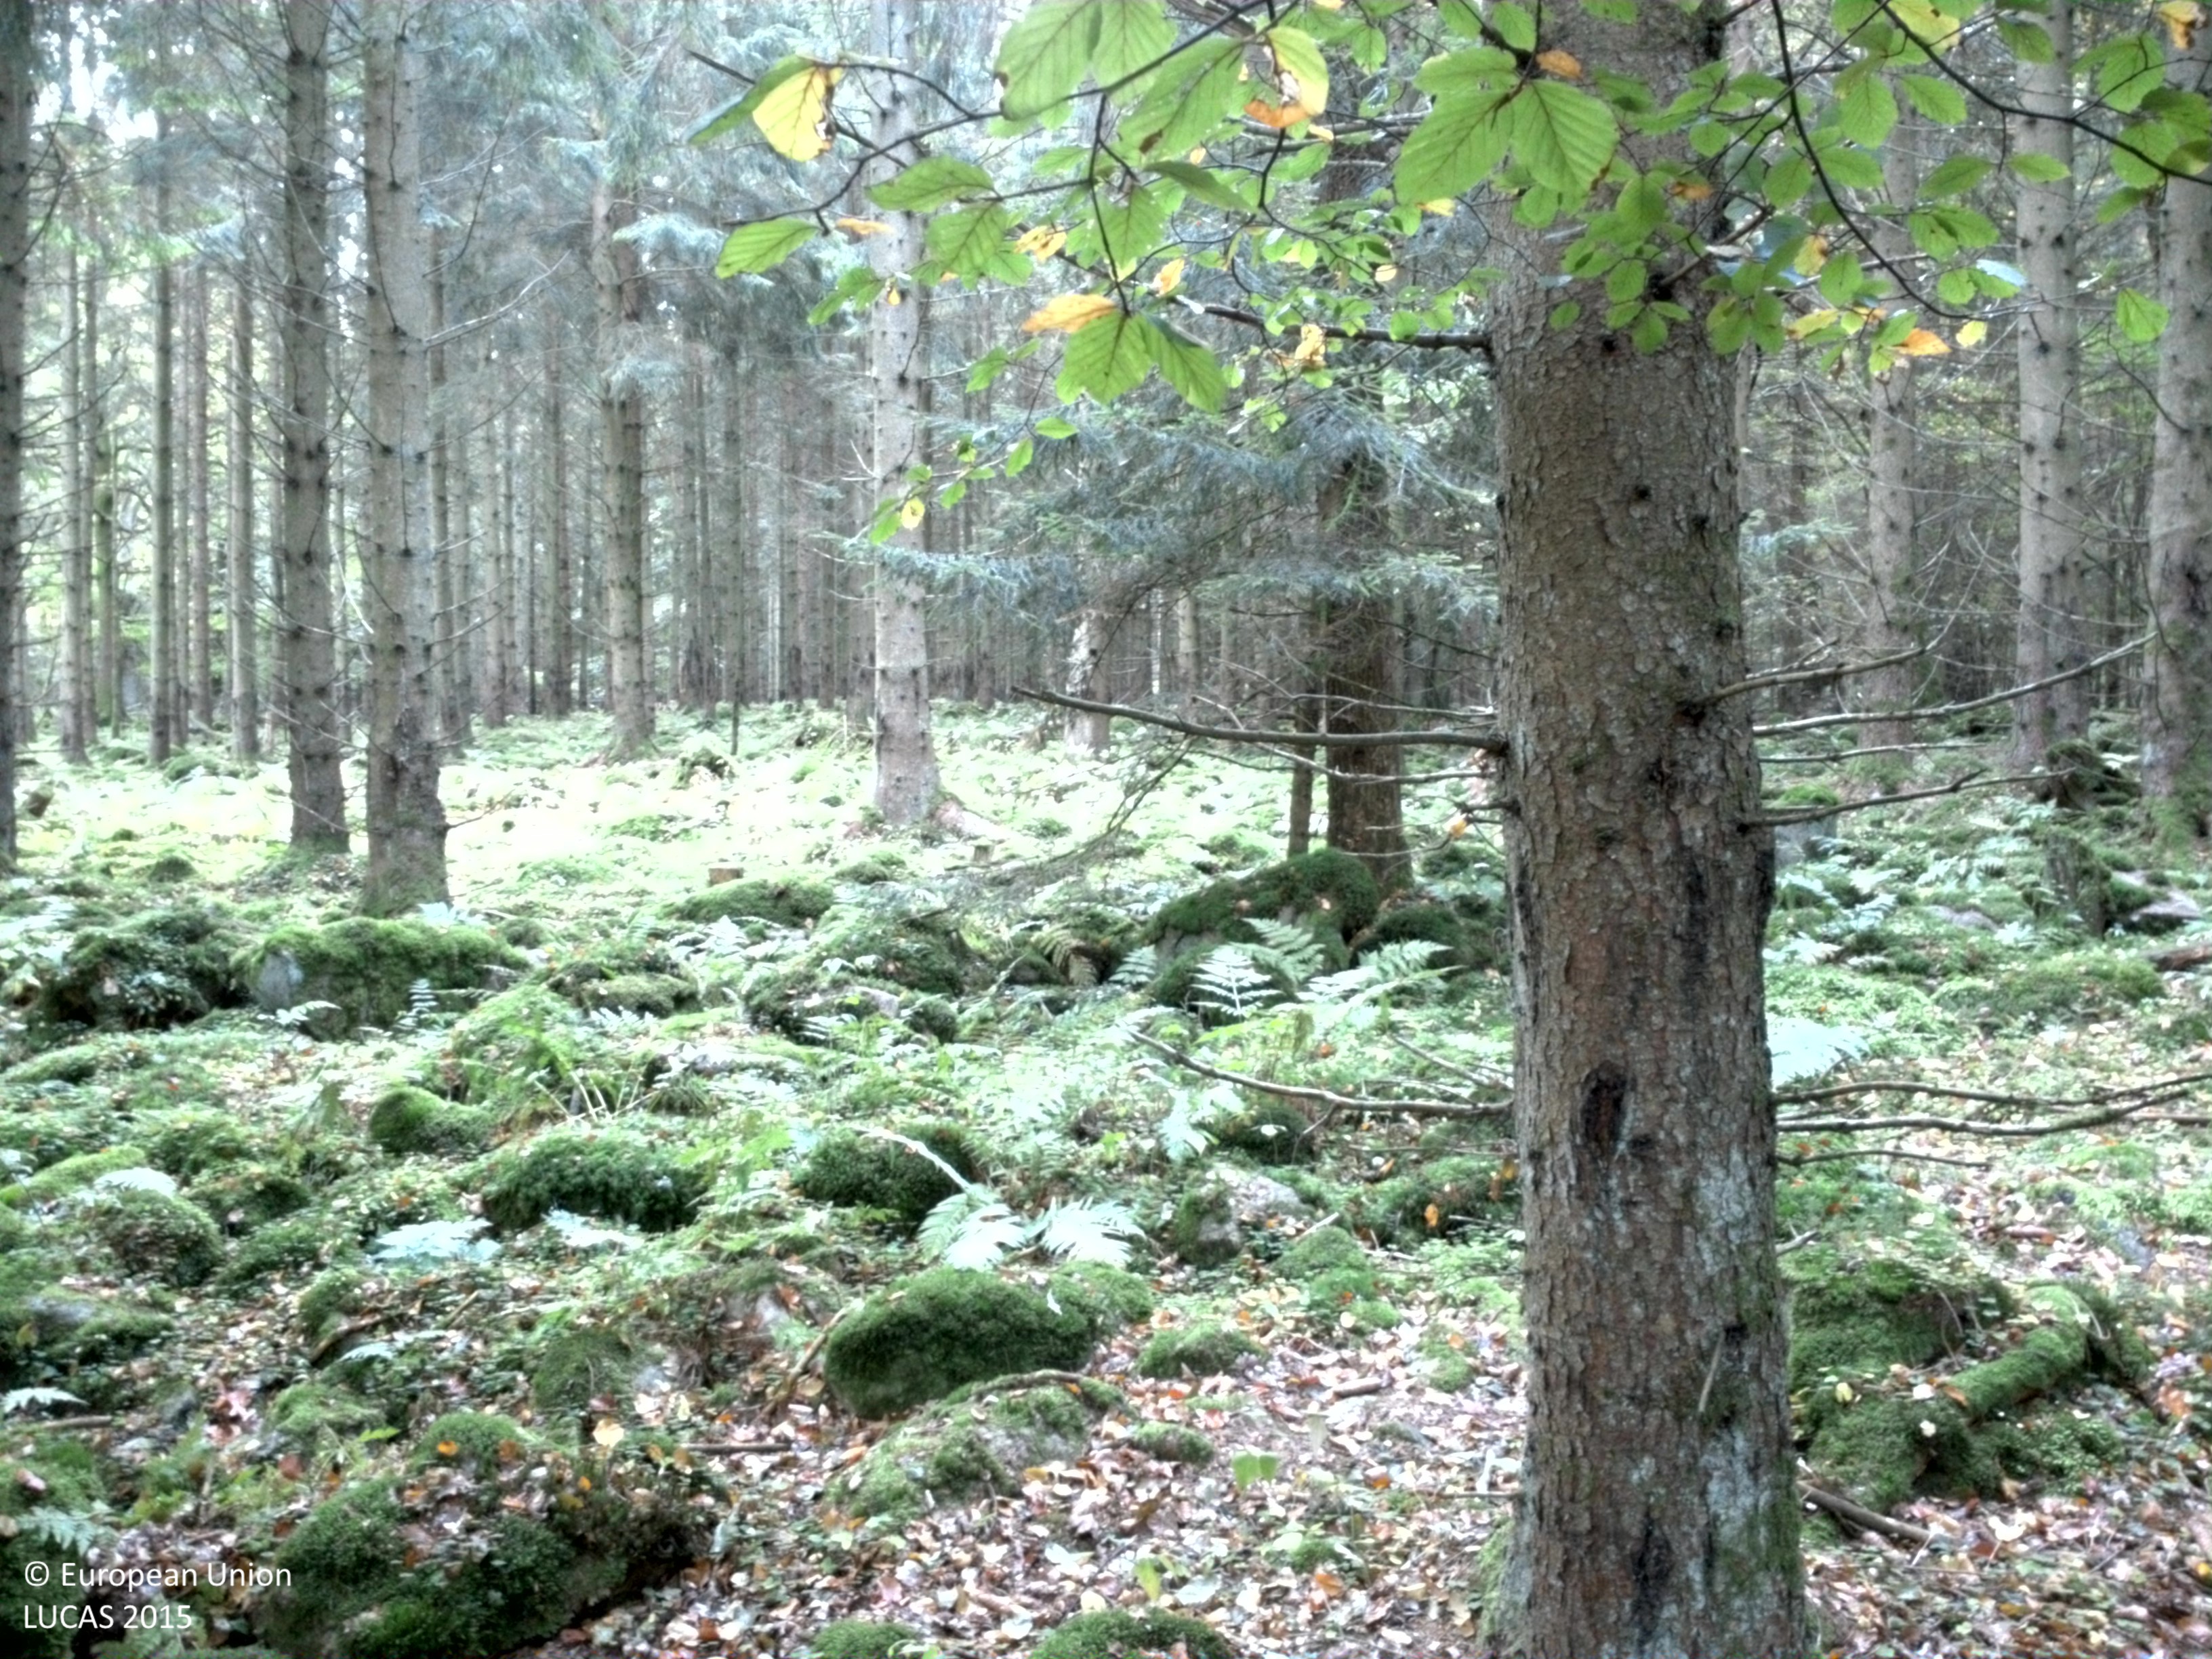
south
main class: Woodland
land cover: Broadleaved woodland
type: mesophytic deciduous forest
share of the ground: > 75 %
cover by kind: broadleaved forest trees 75 %, coniferous forest trees 5 %, shrubs 5 %, herbaceous plants 5 %, lichens and mosses 5 %, unconsolidated bare surface 5 %
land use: Forestry
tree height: > 5 m
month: October
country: SE
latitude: 55.6938
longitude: 13.9914
